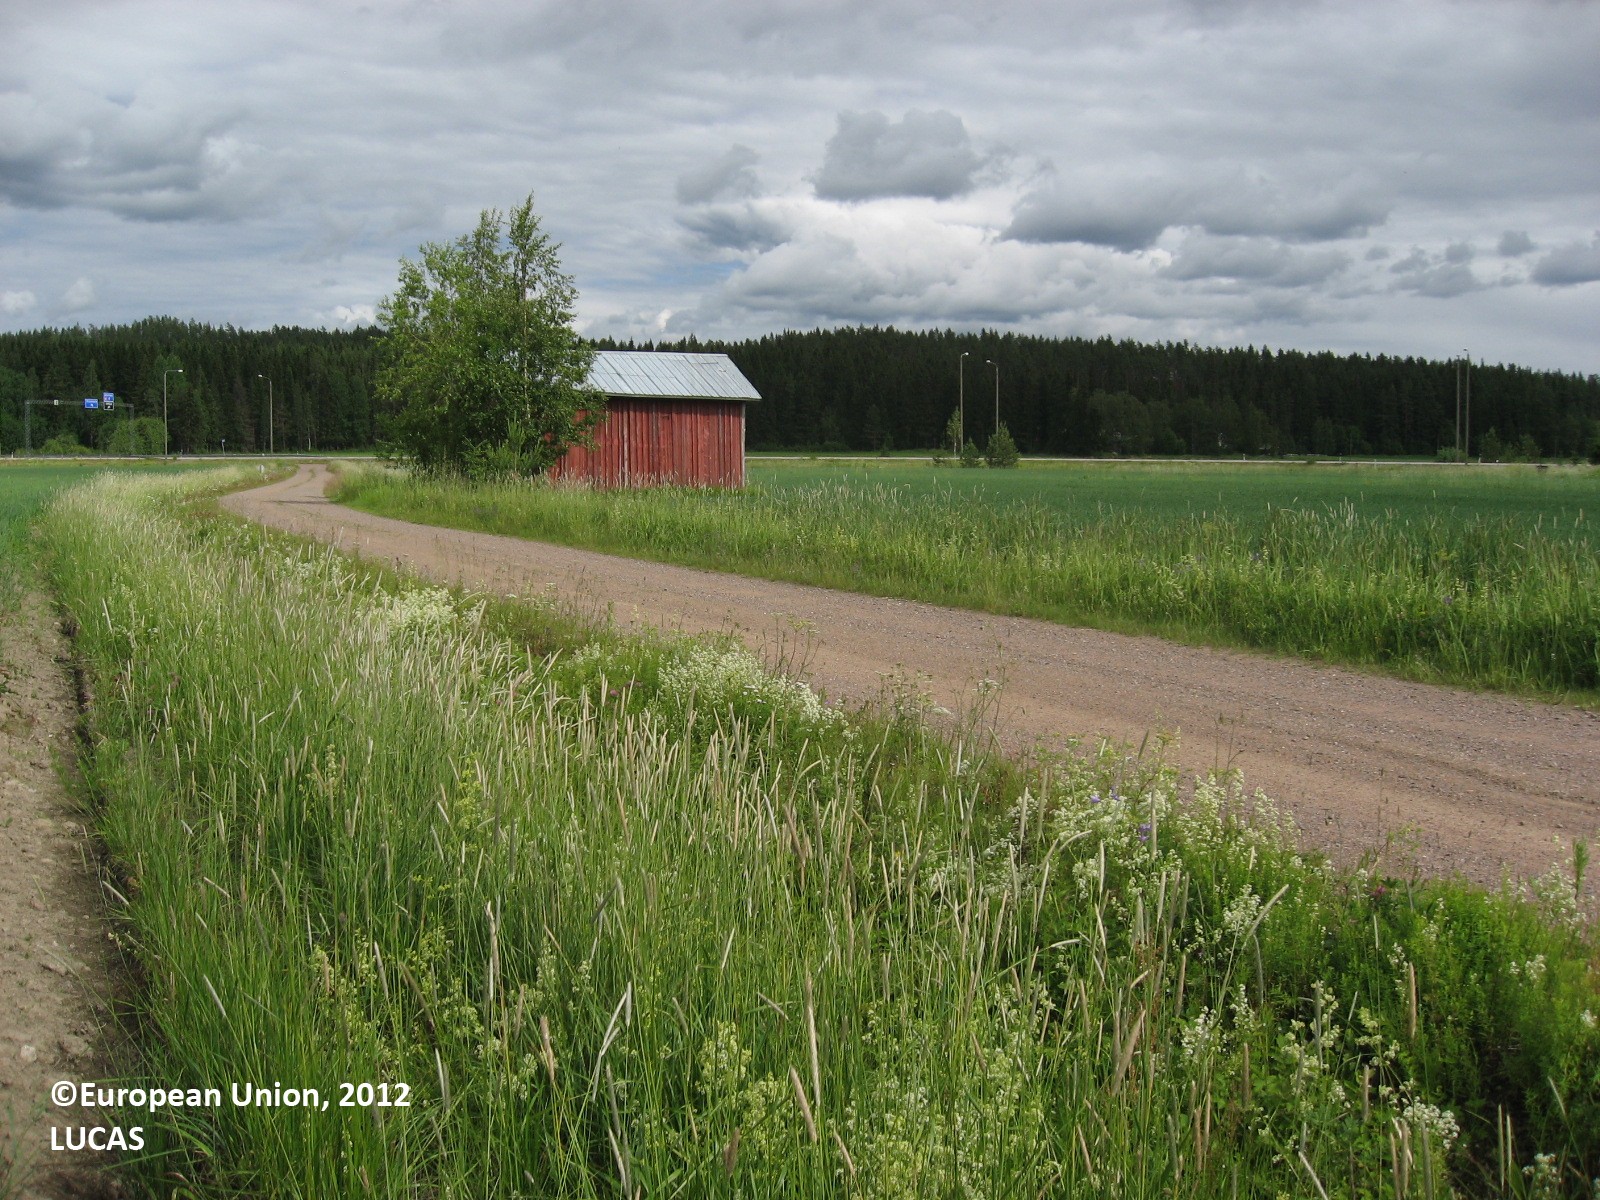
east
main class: Cropland
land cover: Oats
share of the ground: > 75 %
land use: Agriculture (excluding fallow land and kitchen gardens)
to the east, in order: Oats; Grass margins; Ditches and canals; Grass margins; Paved roads, cycling and walking lanes; Grass margins; Ditches and canals; Grass margins; Artificial constructions in urban areas; Single bushes/trees; Oats; Grass margins; Paved roads, cycling and walking lanes; Grass margins; Ditches and canals; Grass margins; Electric lines; Paved roads, cycling and walking lanes; Grass margins; Electric lines; Spontaneously vegetated surfaces; Ditches and canals; Grass margins; Paved roads, cycling and walking lanes
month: June
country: FI
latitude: 60.7707
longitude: 26.4739
